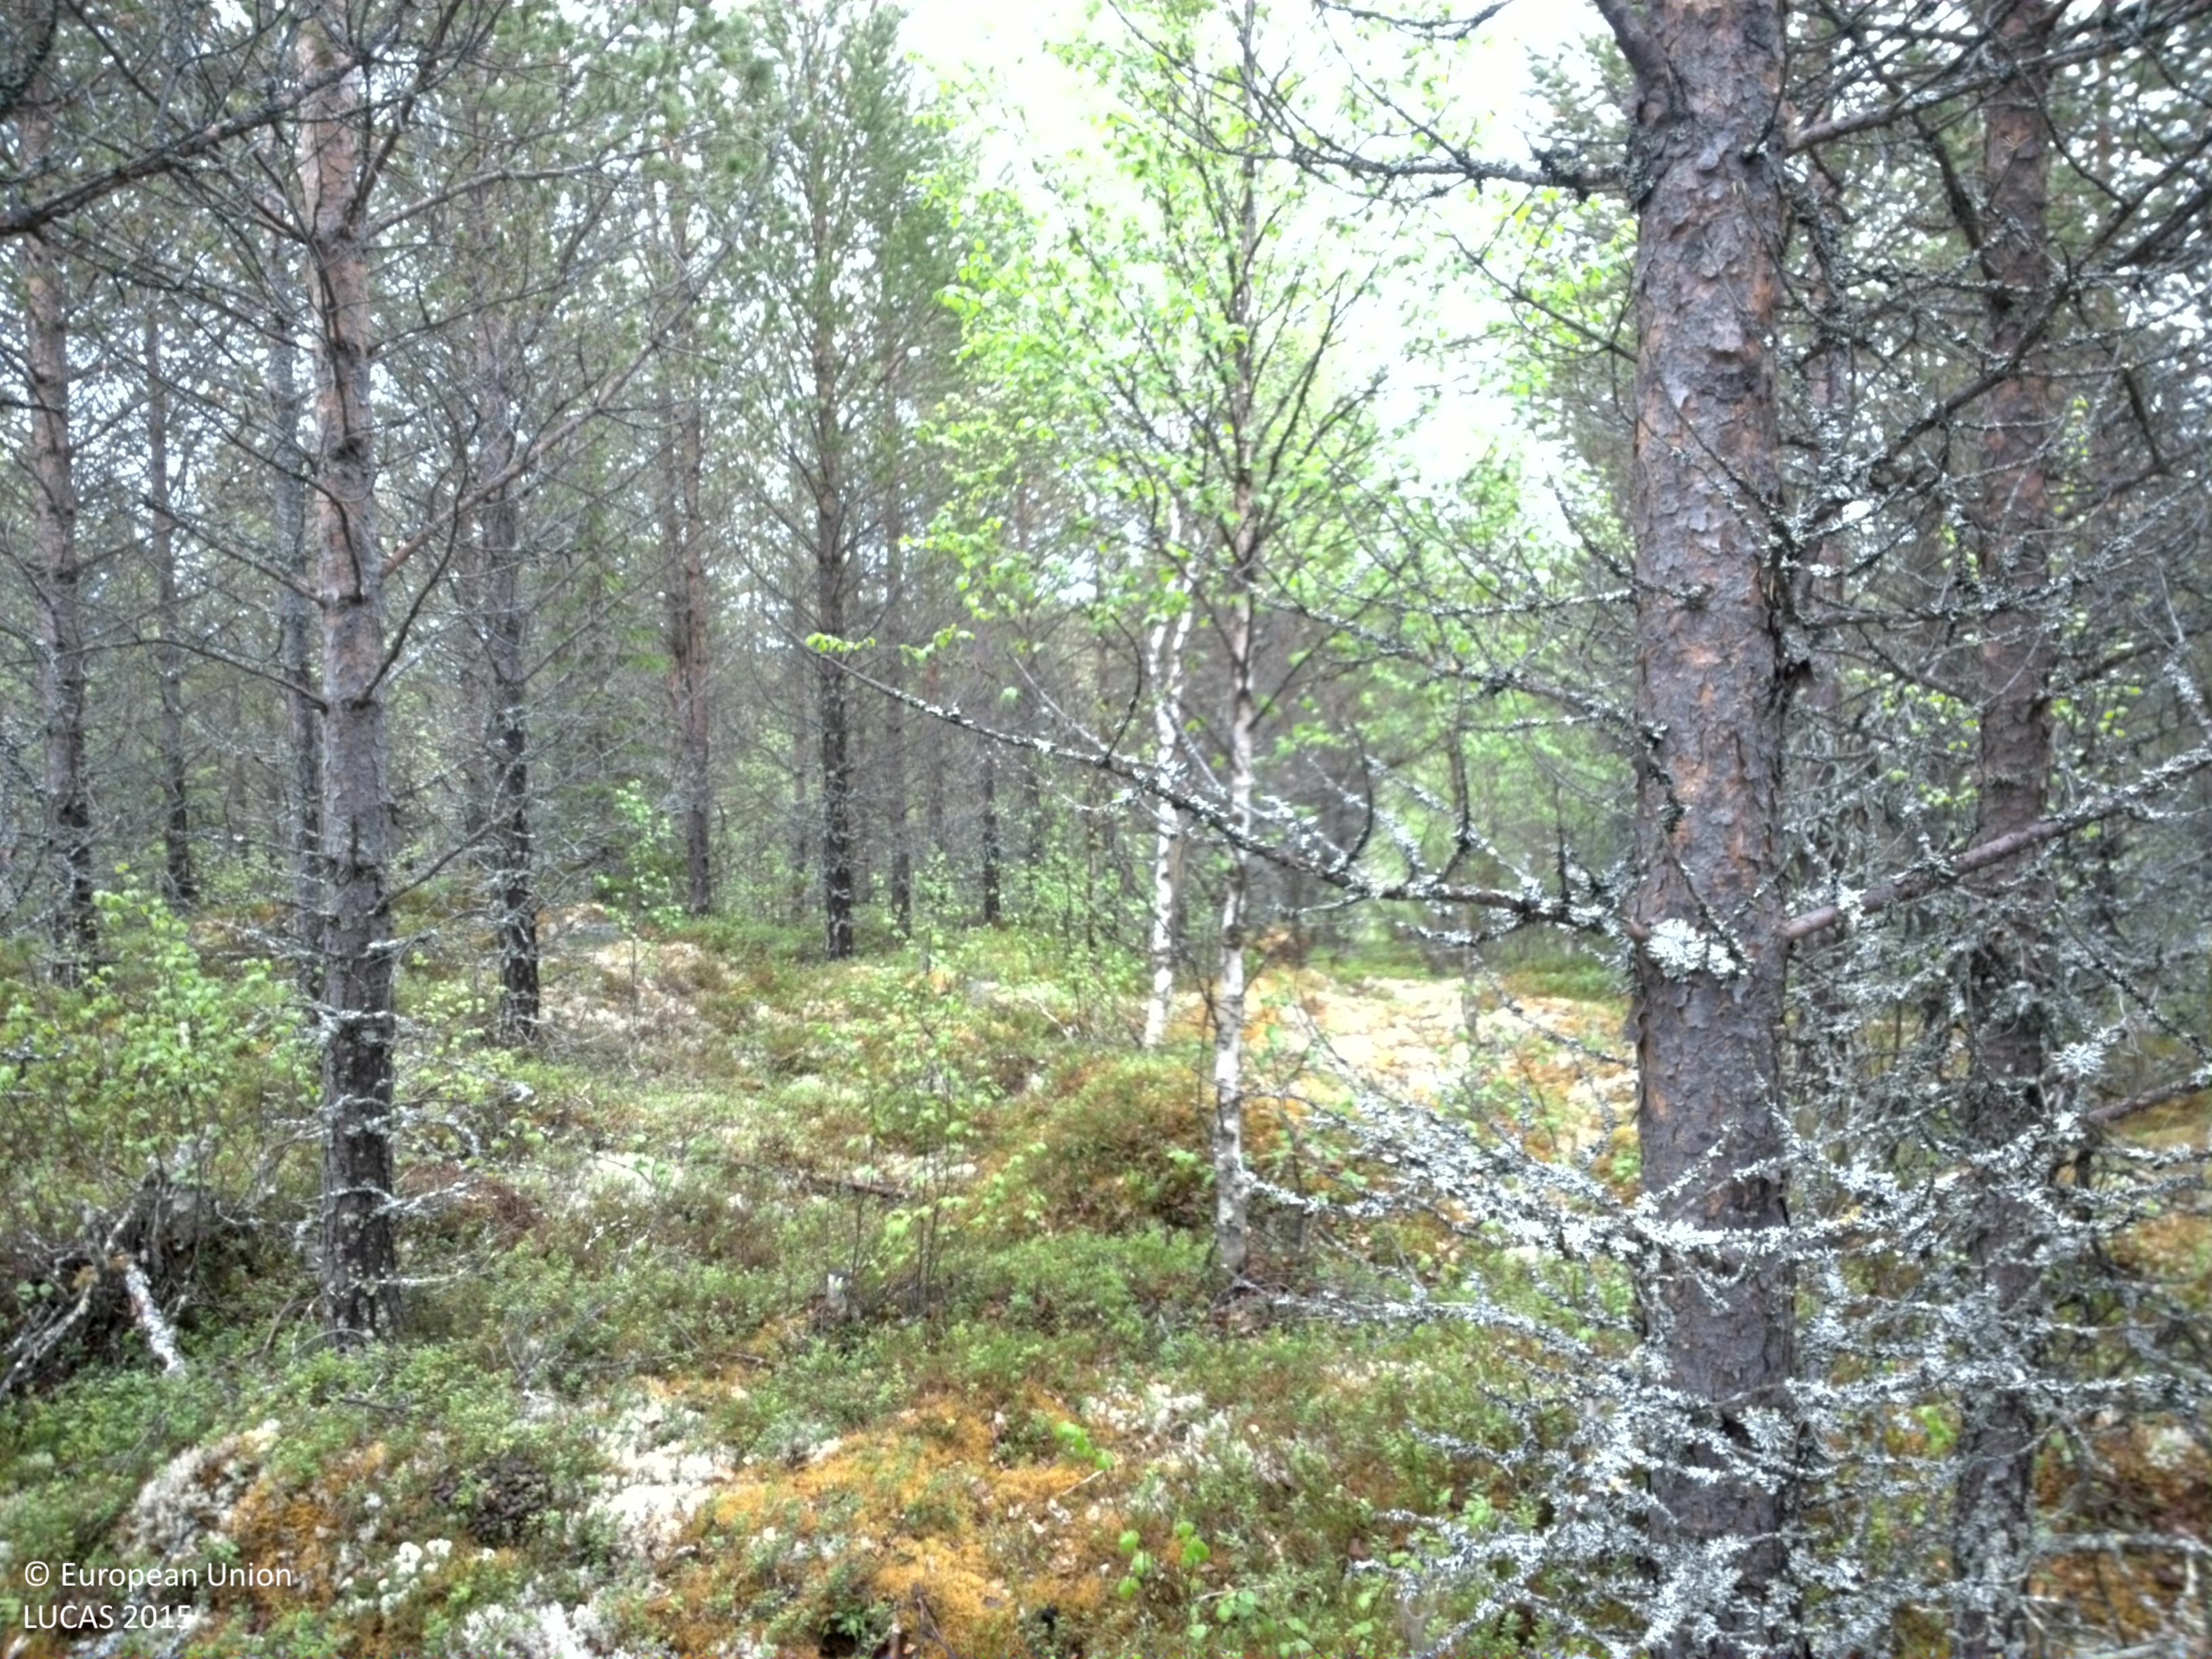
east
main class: Woodland
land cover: Pine dominated mixed woodland
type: boreal forest
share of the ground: 50 - 75 %
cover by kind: coniferous forest trees 40 %, shrubs 35 %, broadleaved forest trees 15 %, lichens and mosses 10 %
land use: Forestry
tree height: > 5 m
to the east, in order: Pine dominated mixed woodland; Broadleaved woodland; Spruce dominated mixed woodland; Shrubland with sparse tree cover; Rivers and streams; Broadleaved woodland; Shrubland with sparse tree cover; Pine dominated coniferous woodland; Pine dominated mixed woodland; Pine dominated coniferous woodland
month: June
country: SE
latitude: 62.0640
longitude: 13.6018
